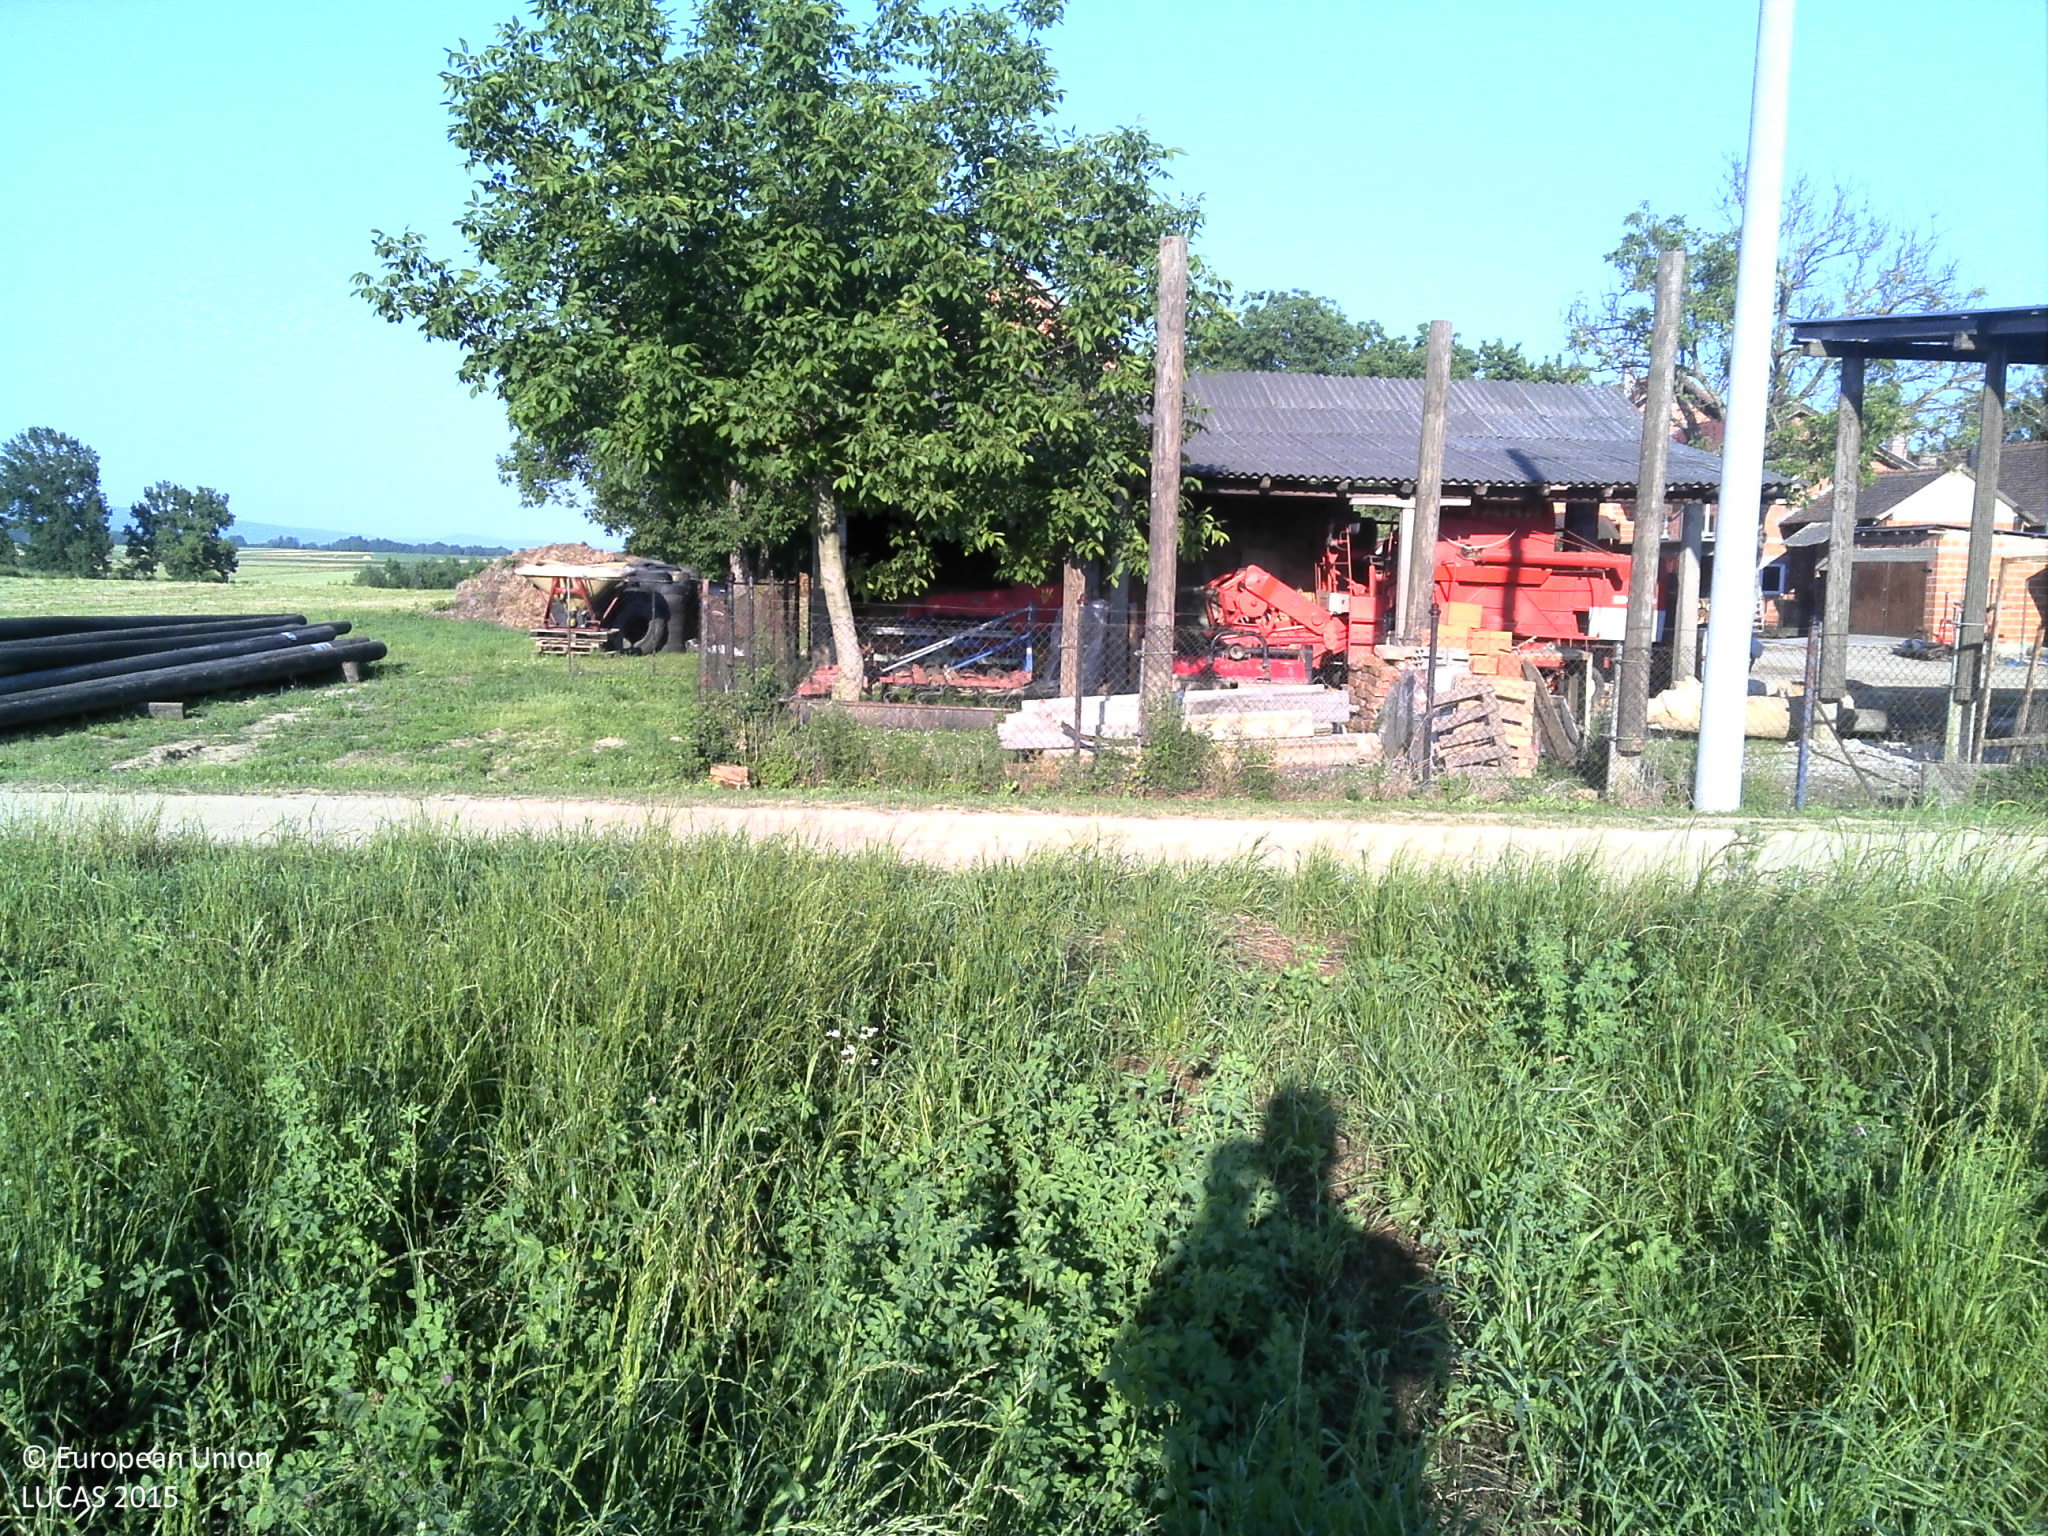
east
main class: Cropland
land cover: Clovers
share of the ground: 50 - 75 %
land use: Agriculture (excluding fallow land and kitchen gardens)
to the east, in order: Clovers; Tracks; Fences; Common wheat; Maize
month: June
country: HR
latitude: 45.4035
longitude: 17.7058
